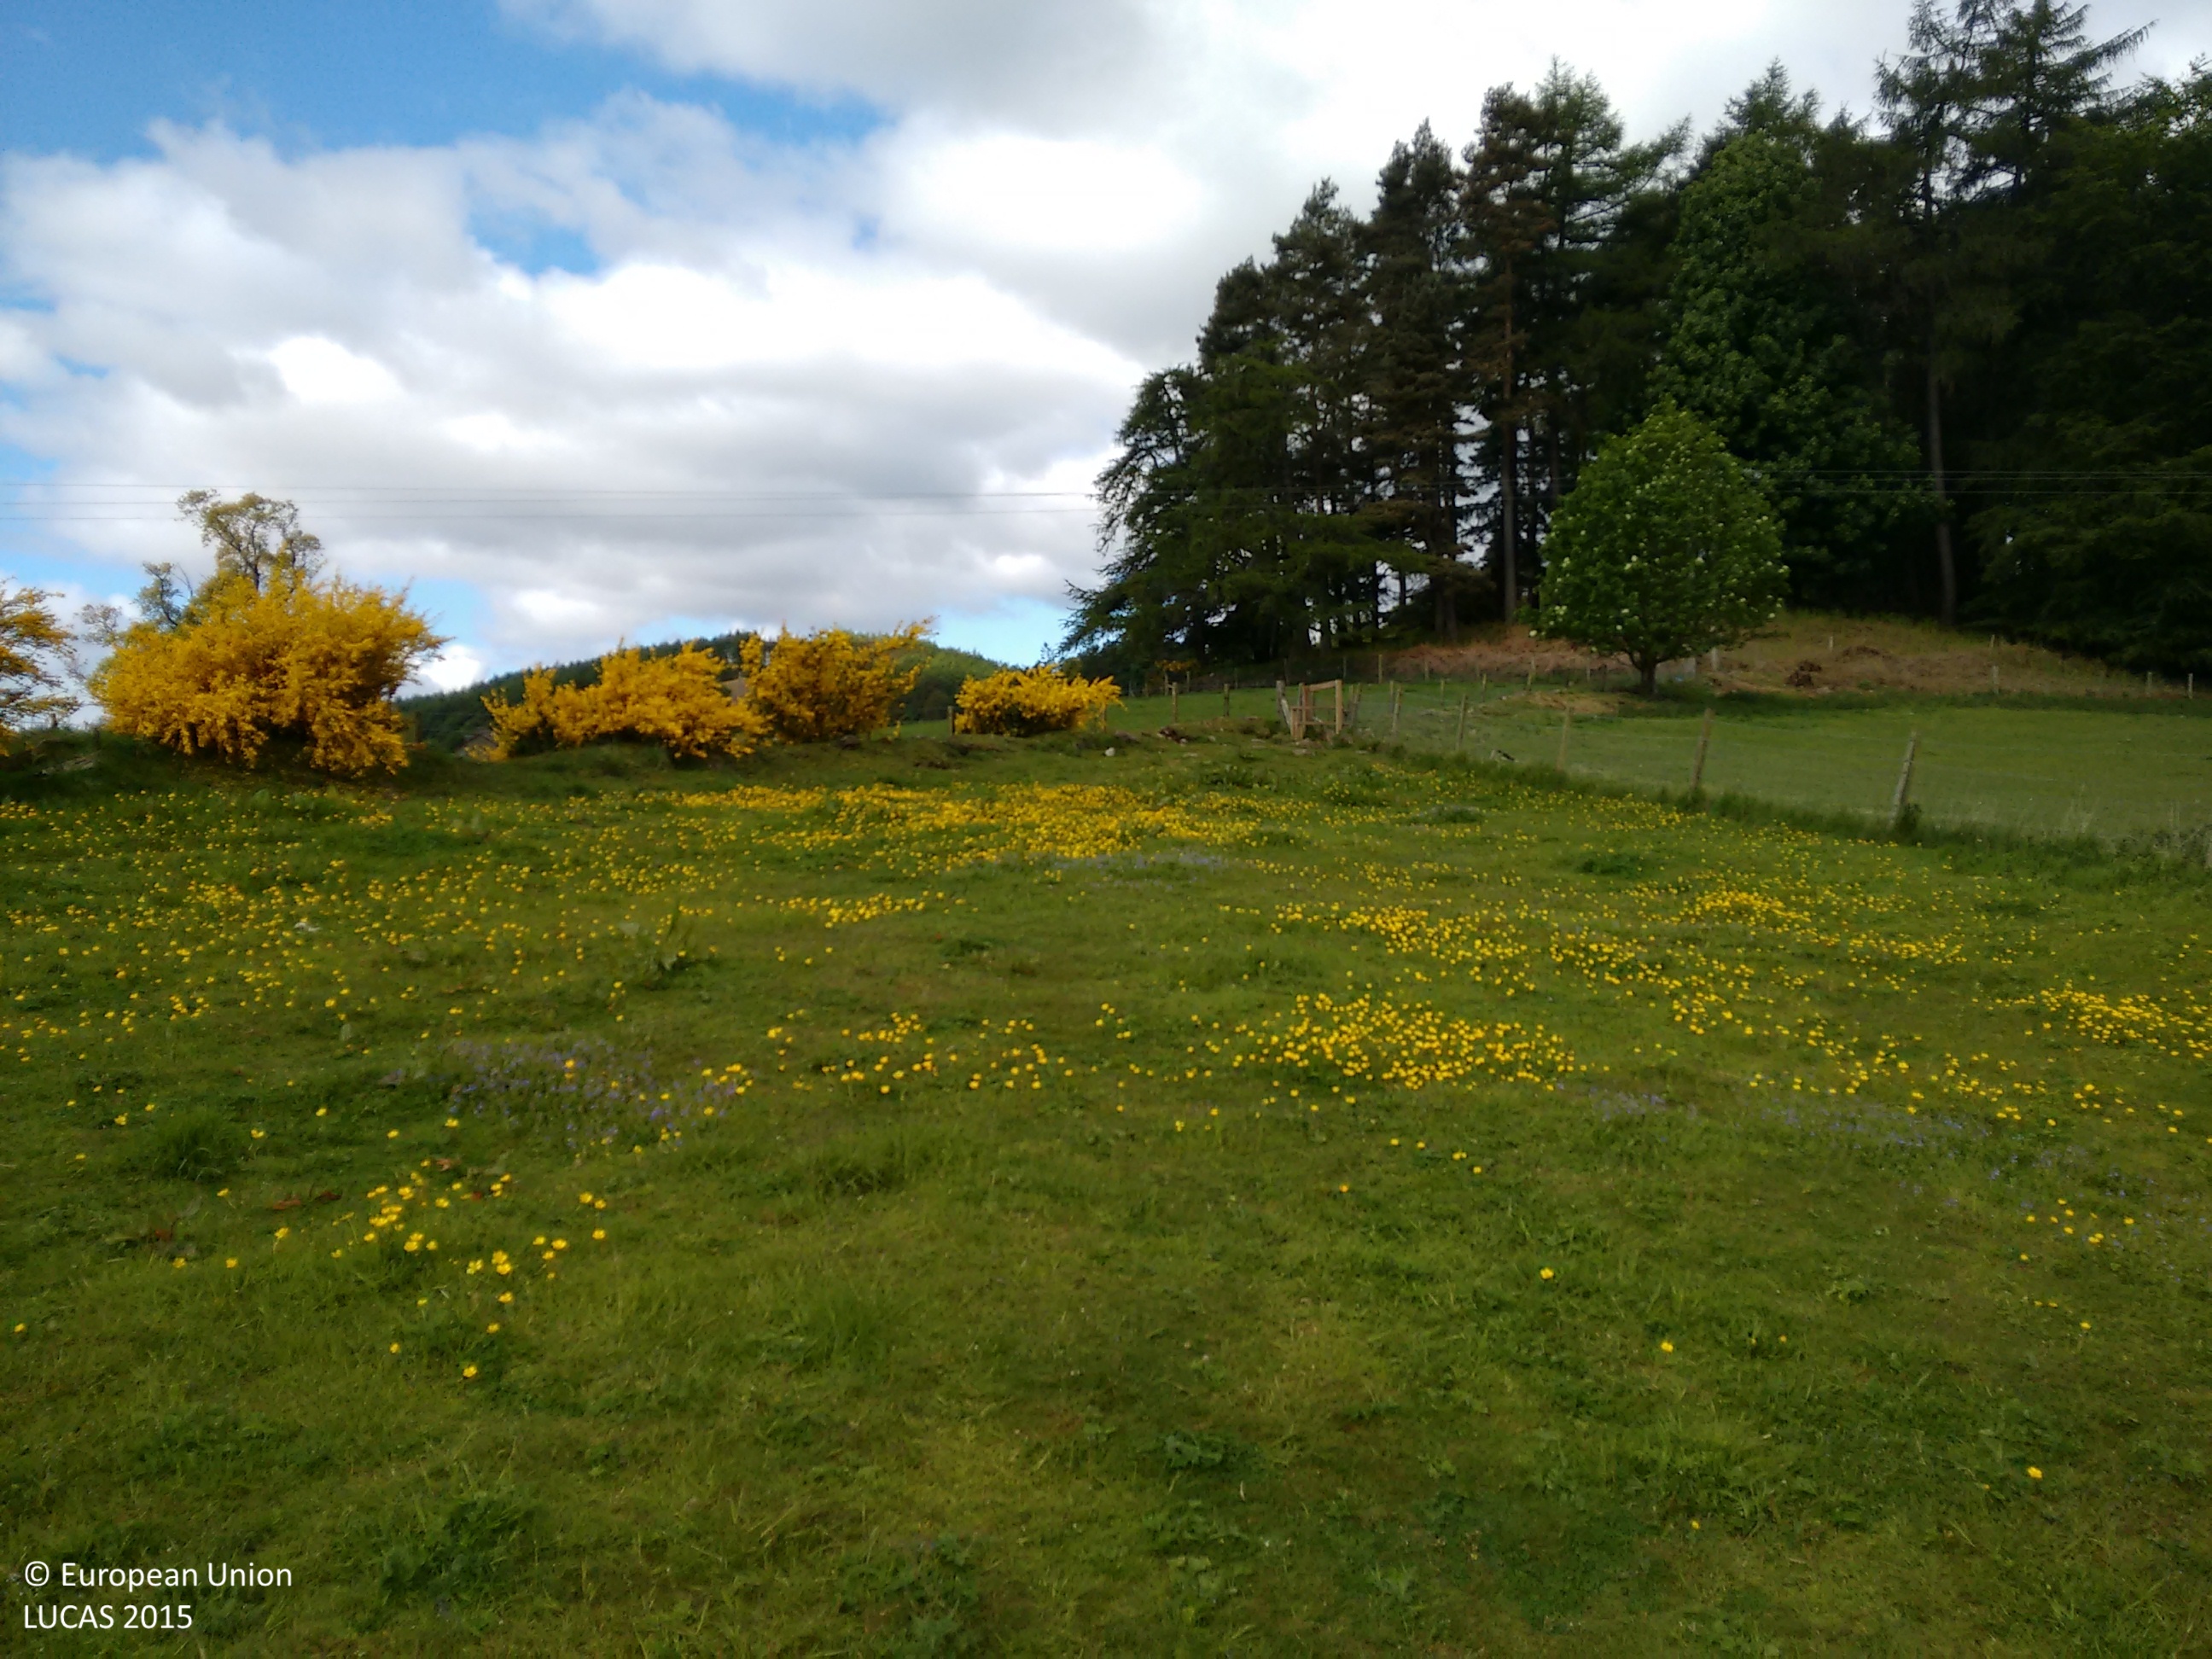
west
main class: Grassland
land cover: Grassland without tree/shrub cover
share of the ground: > 75 %
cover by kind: herbaceous plants 100 %
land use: Agriculture (excluding fallow land and kitchen gardens)
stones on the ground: 10 - 25 %
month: June
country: GB
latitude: 56.3629
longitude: -3.8579
